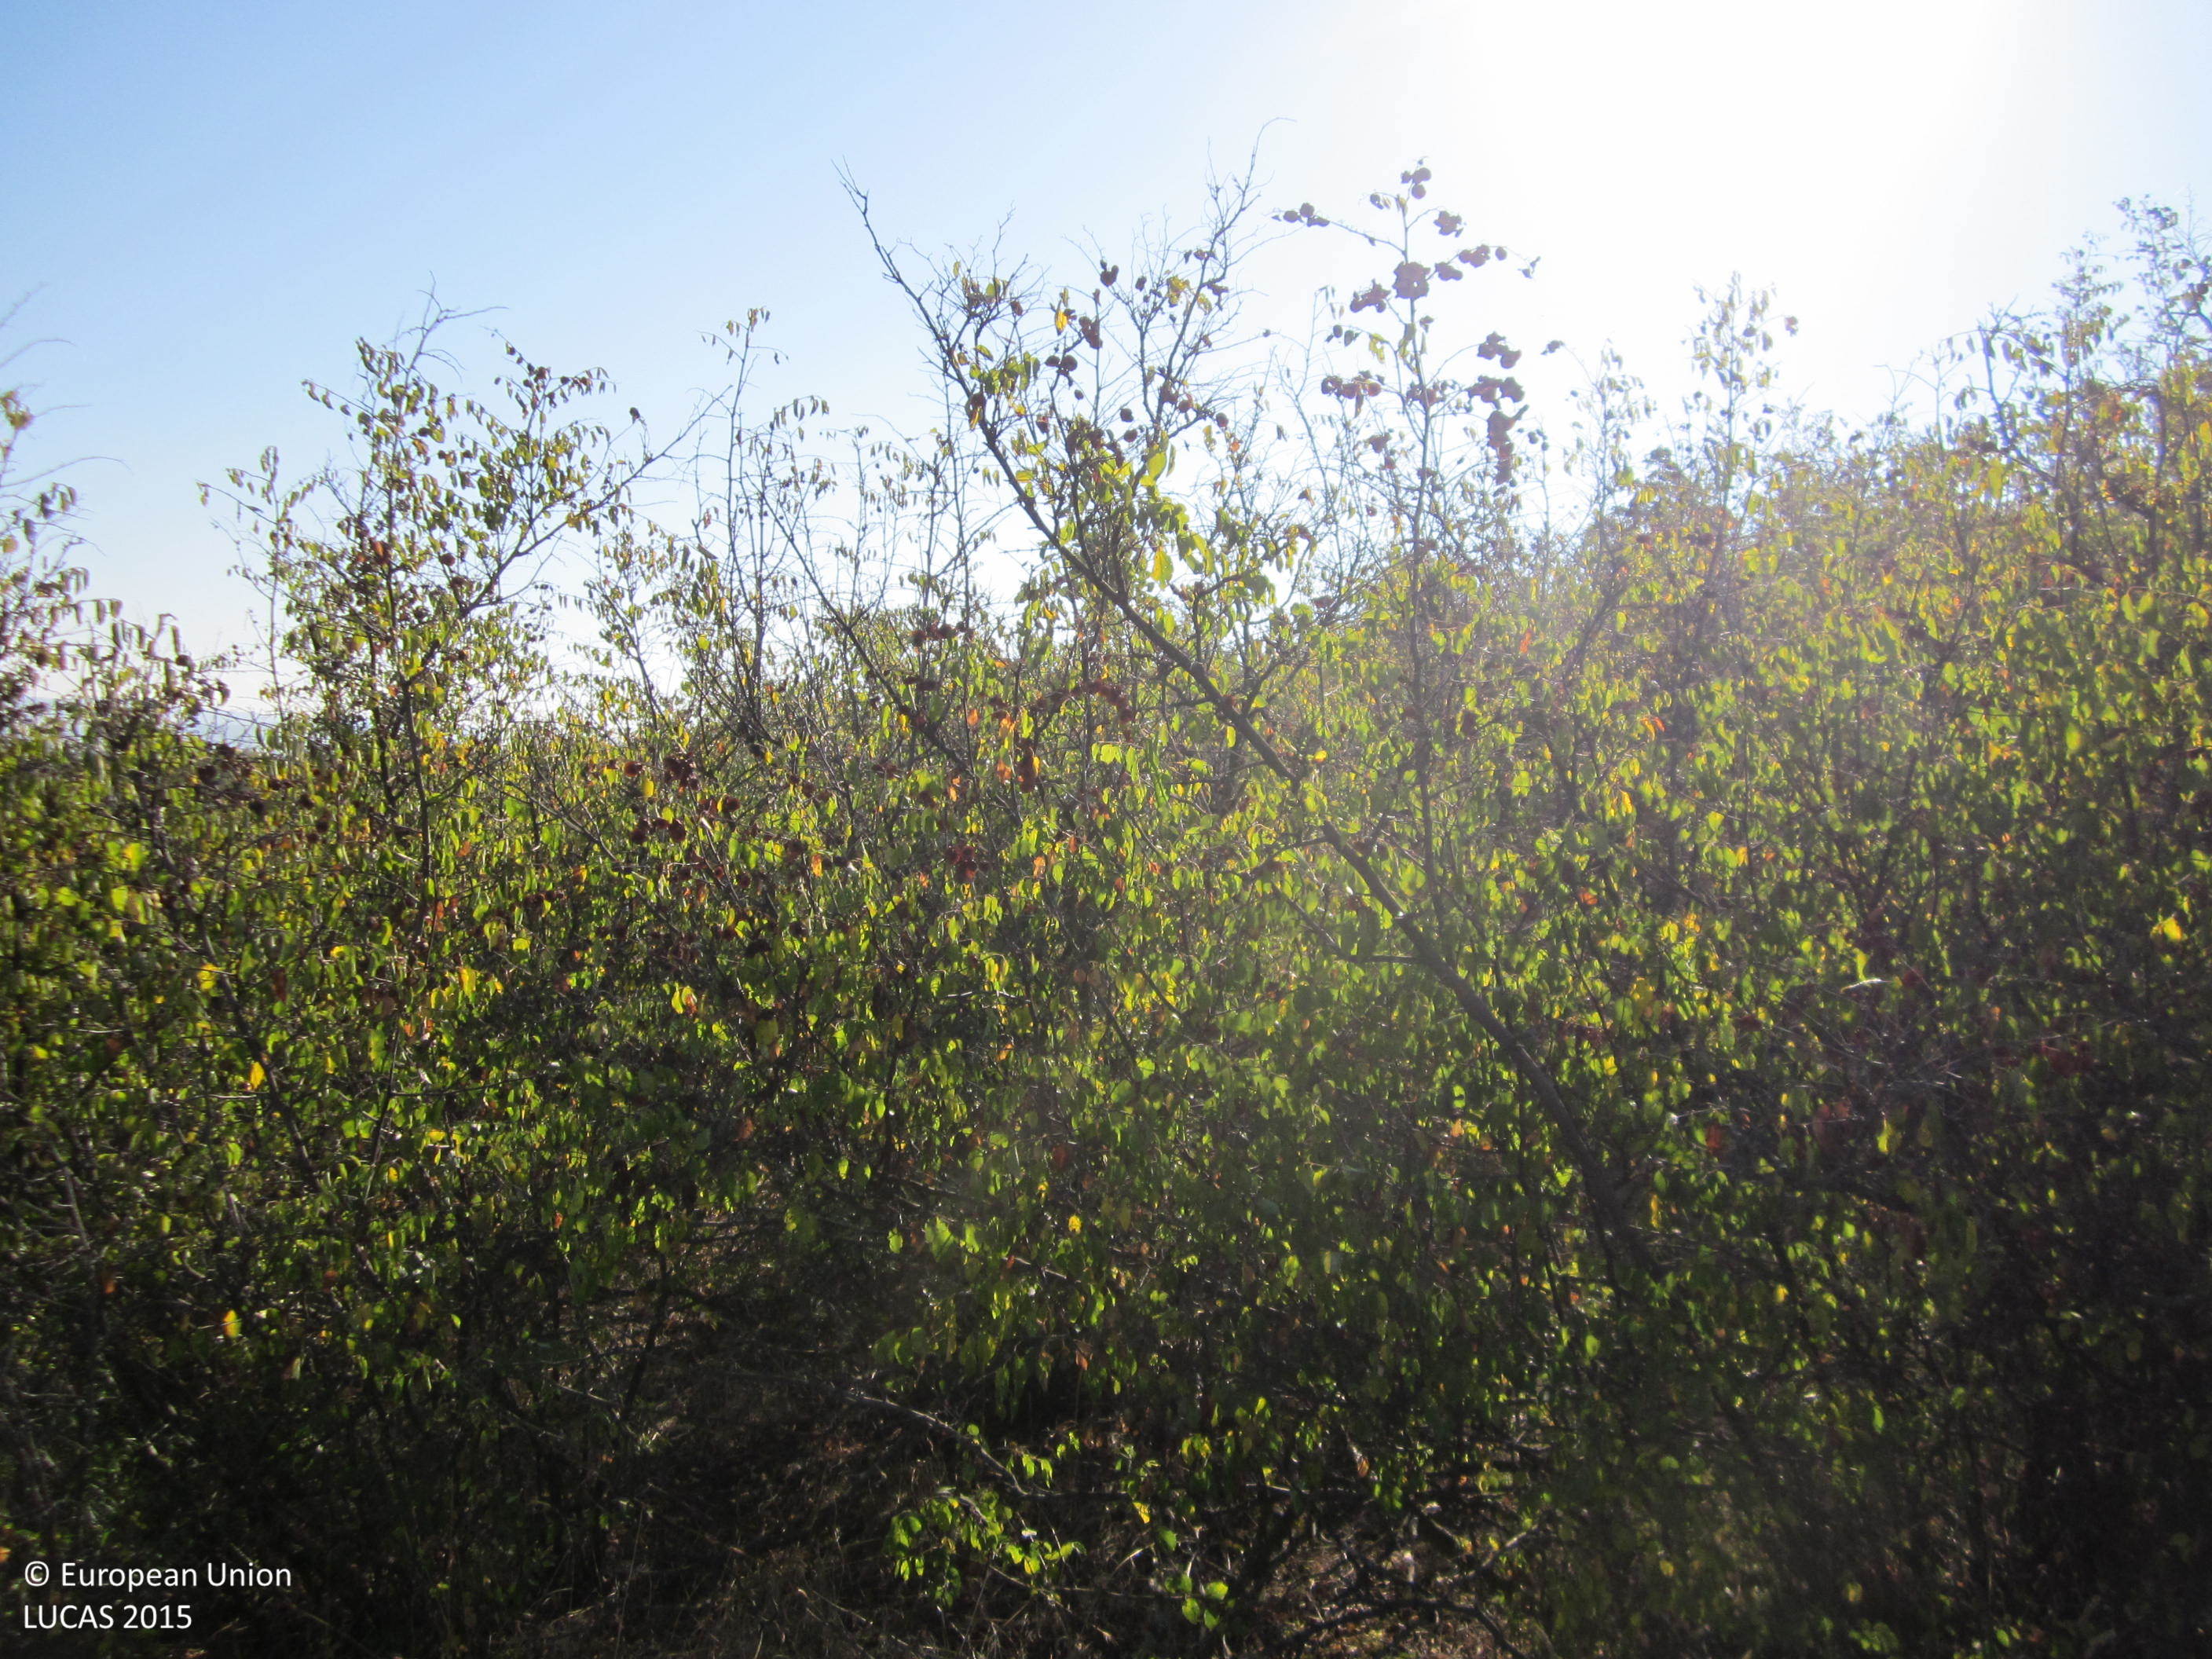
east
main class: Shrubland
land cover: Shrubland without tree cover
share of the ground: 50 - 75 %
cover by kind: shrubs 70 %, herbaceous plants 30 %
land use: Agriculture (excluding fallow land and kitchen gardens)
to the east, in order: Shrubland without tree cover
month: September
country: BG
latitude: 42.6528
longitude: 27.2518
